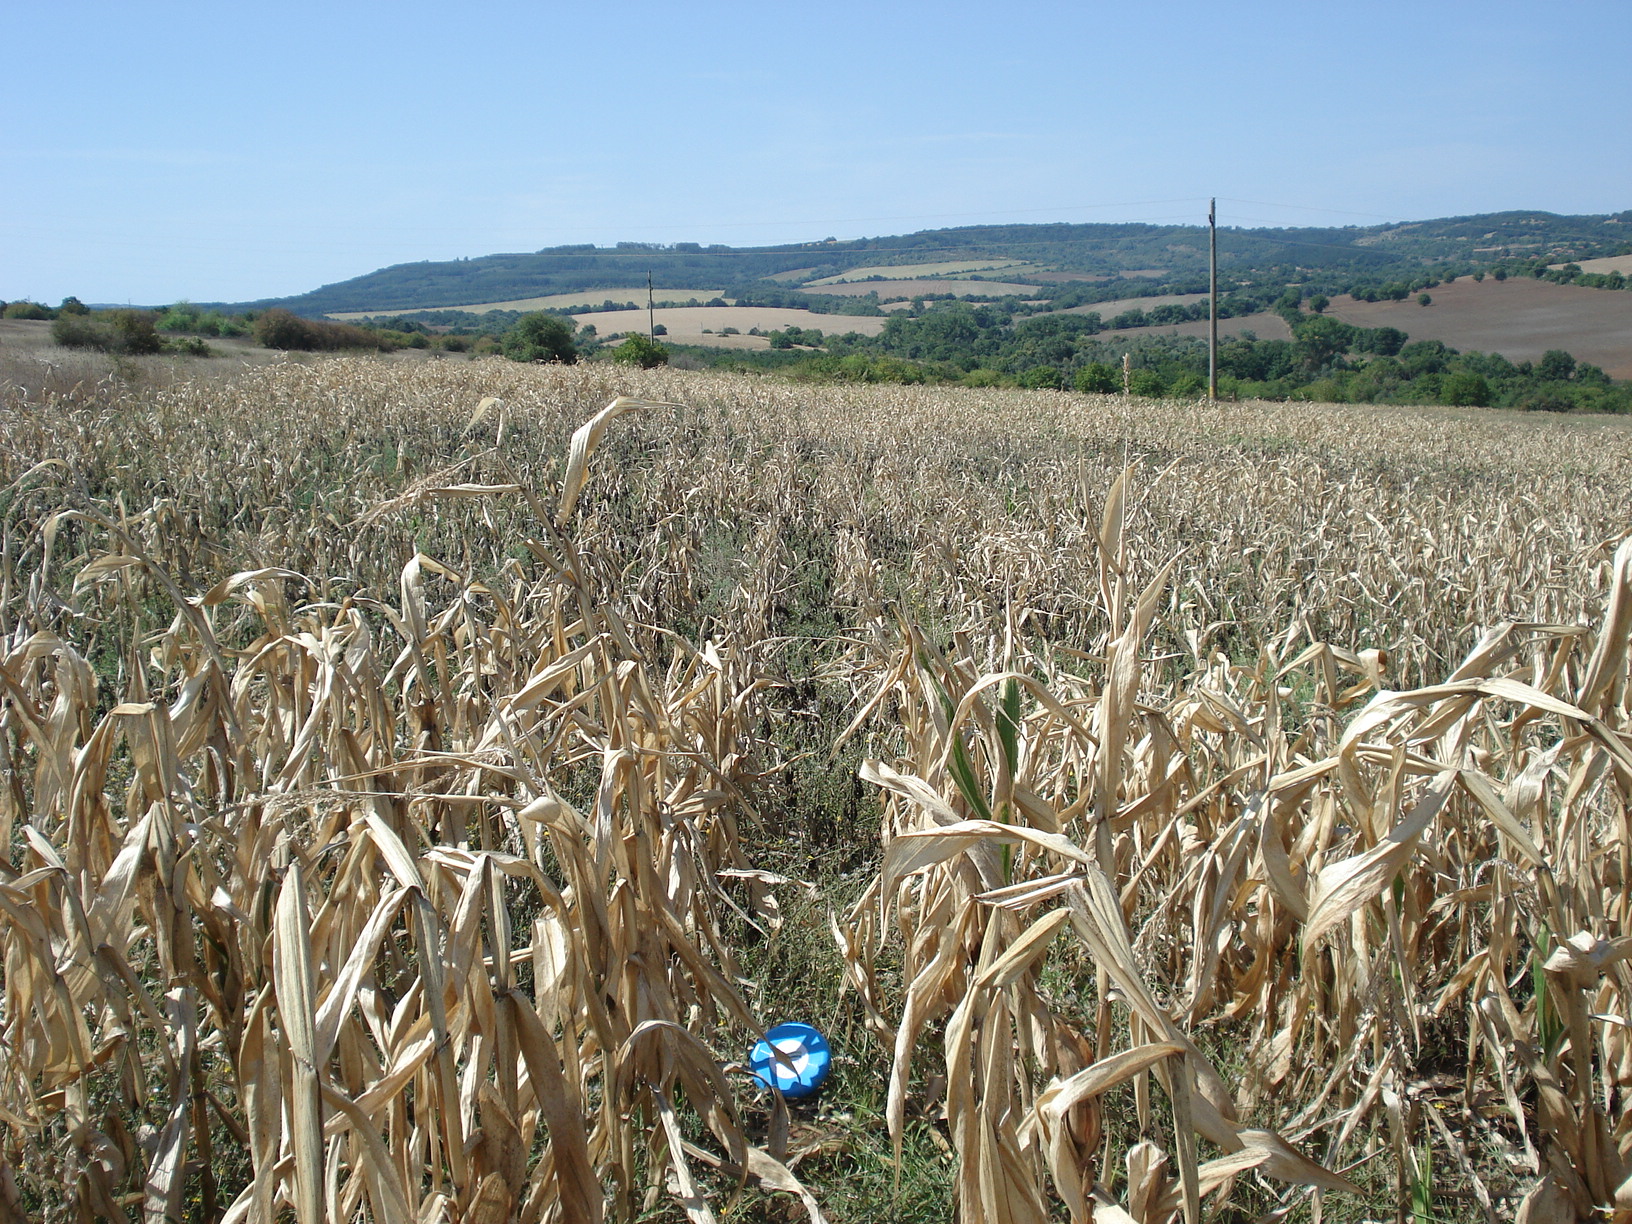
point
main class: Cropland
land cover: Maize
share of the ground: > 75 %
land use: Agriculture (excluding fallow land and kitchen gardens)
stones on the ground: < 10 %
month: September
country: BG
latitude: 43.1478
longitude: 25.3338
